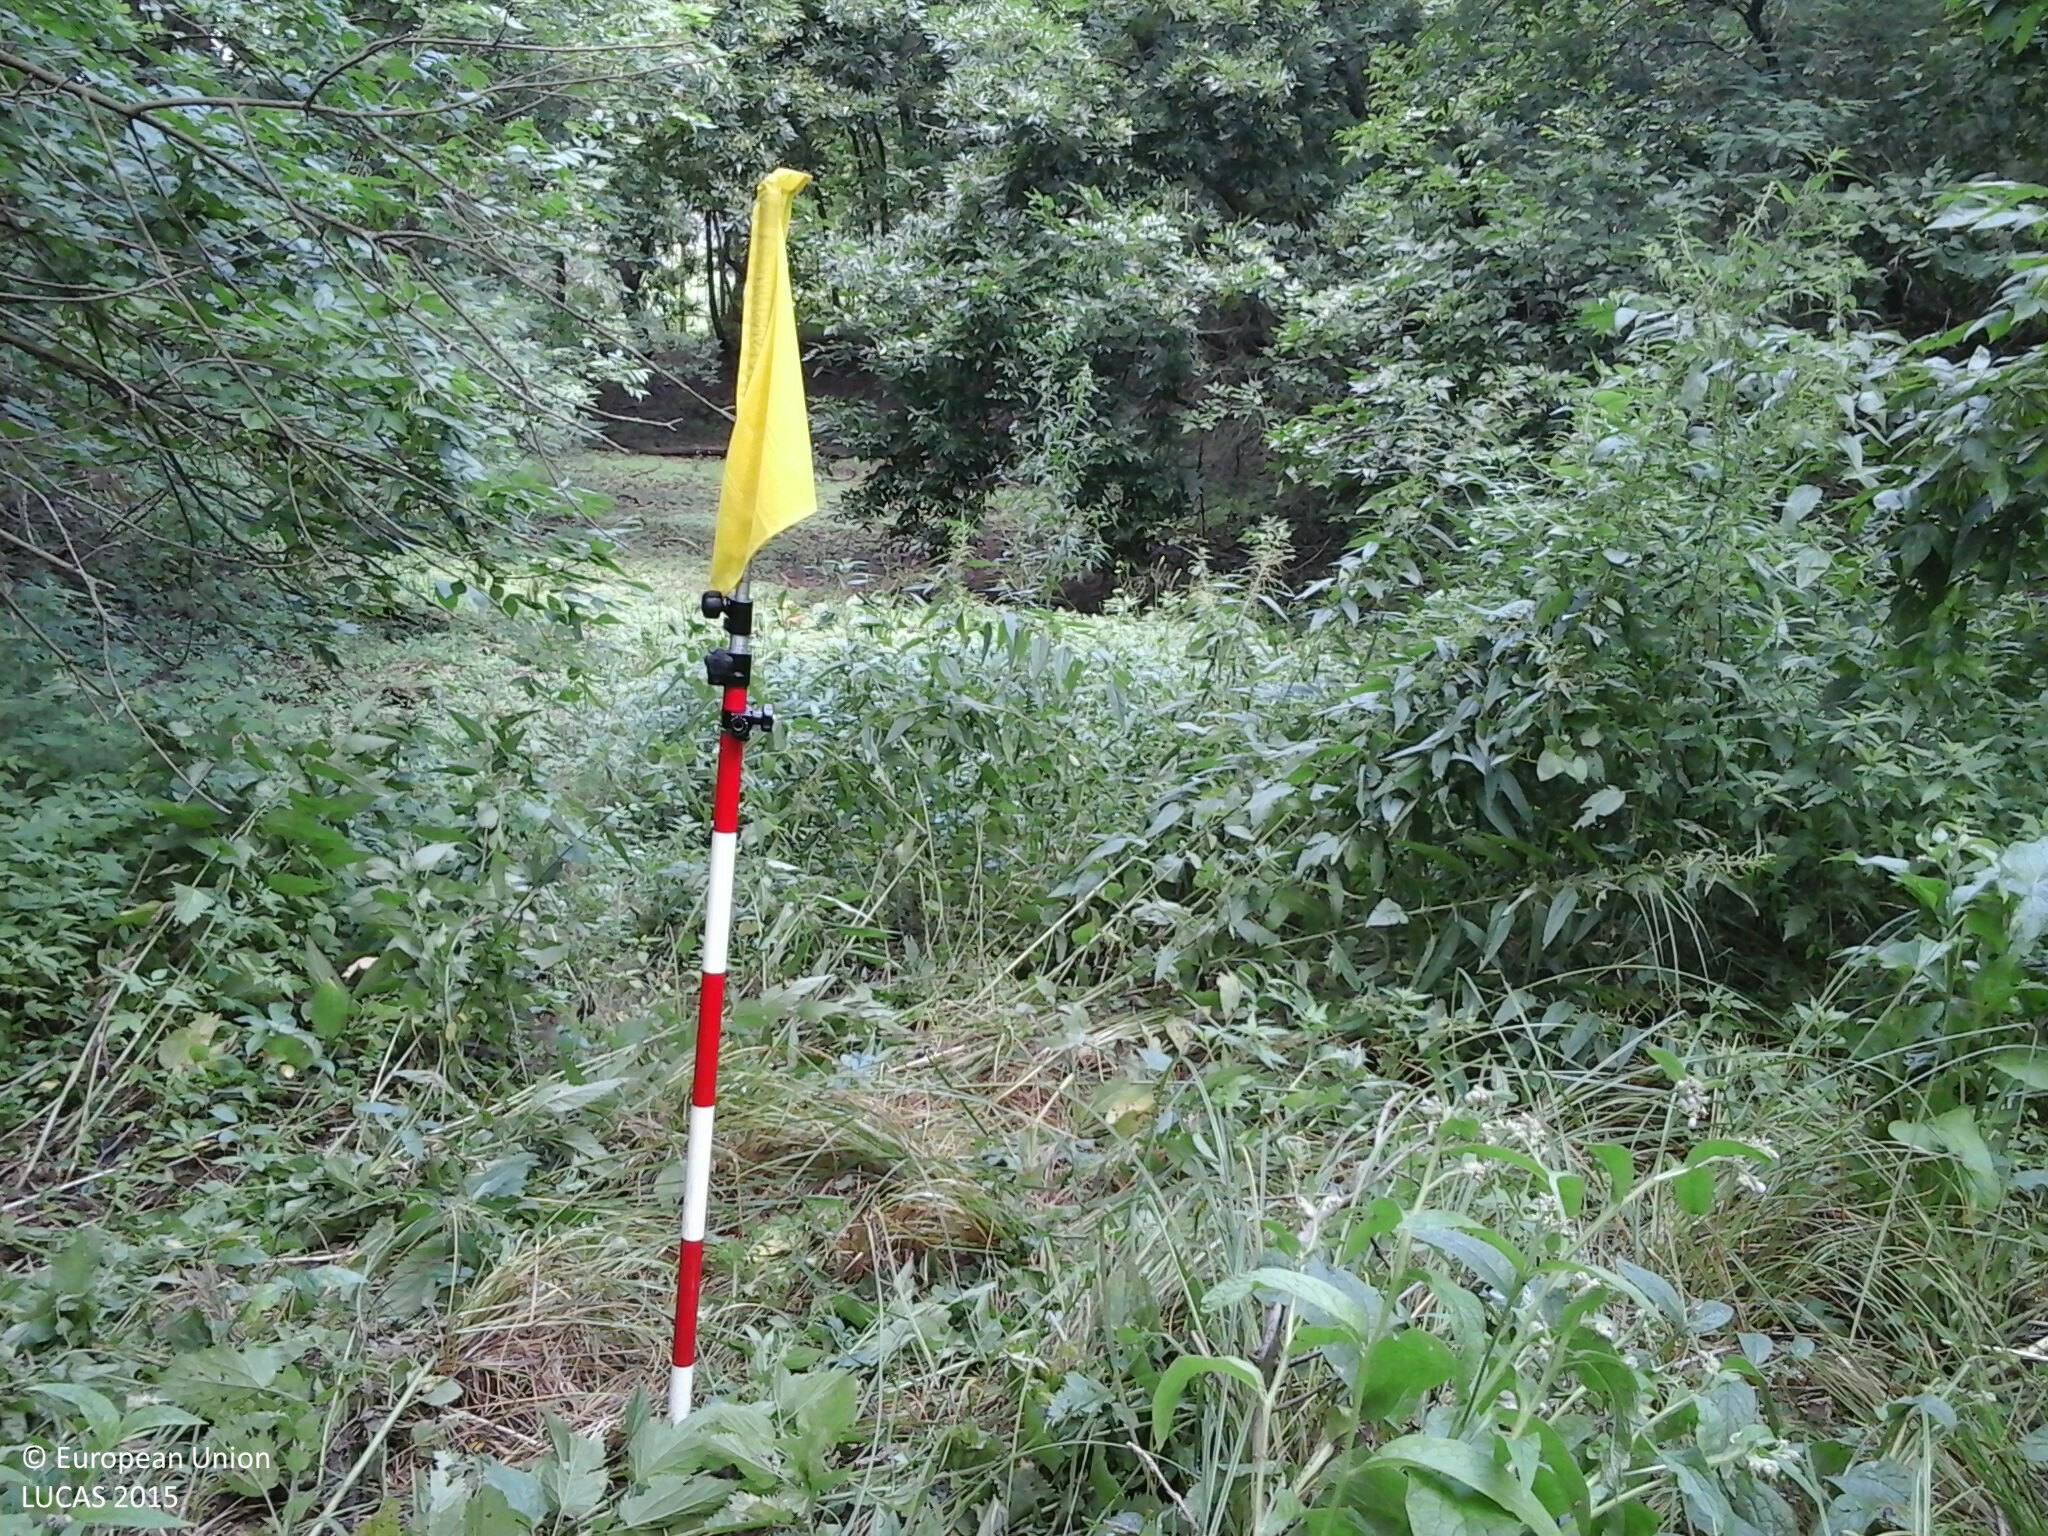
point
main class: Woodland
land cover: Broadleaved woodland
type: mesophytic deciduous forest
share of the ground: > 75 %
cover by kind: broadleaved forest trees 100 %
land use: Forestry
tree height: > 5 m
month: July
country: HU
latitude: 47.7630
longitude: 20.9913
